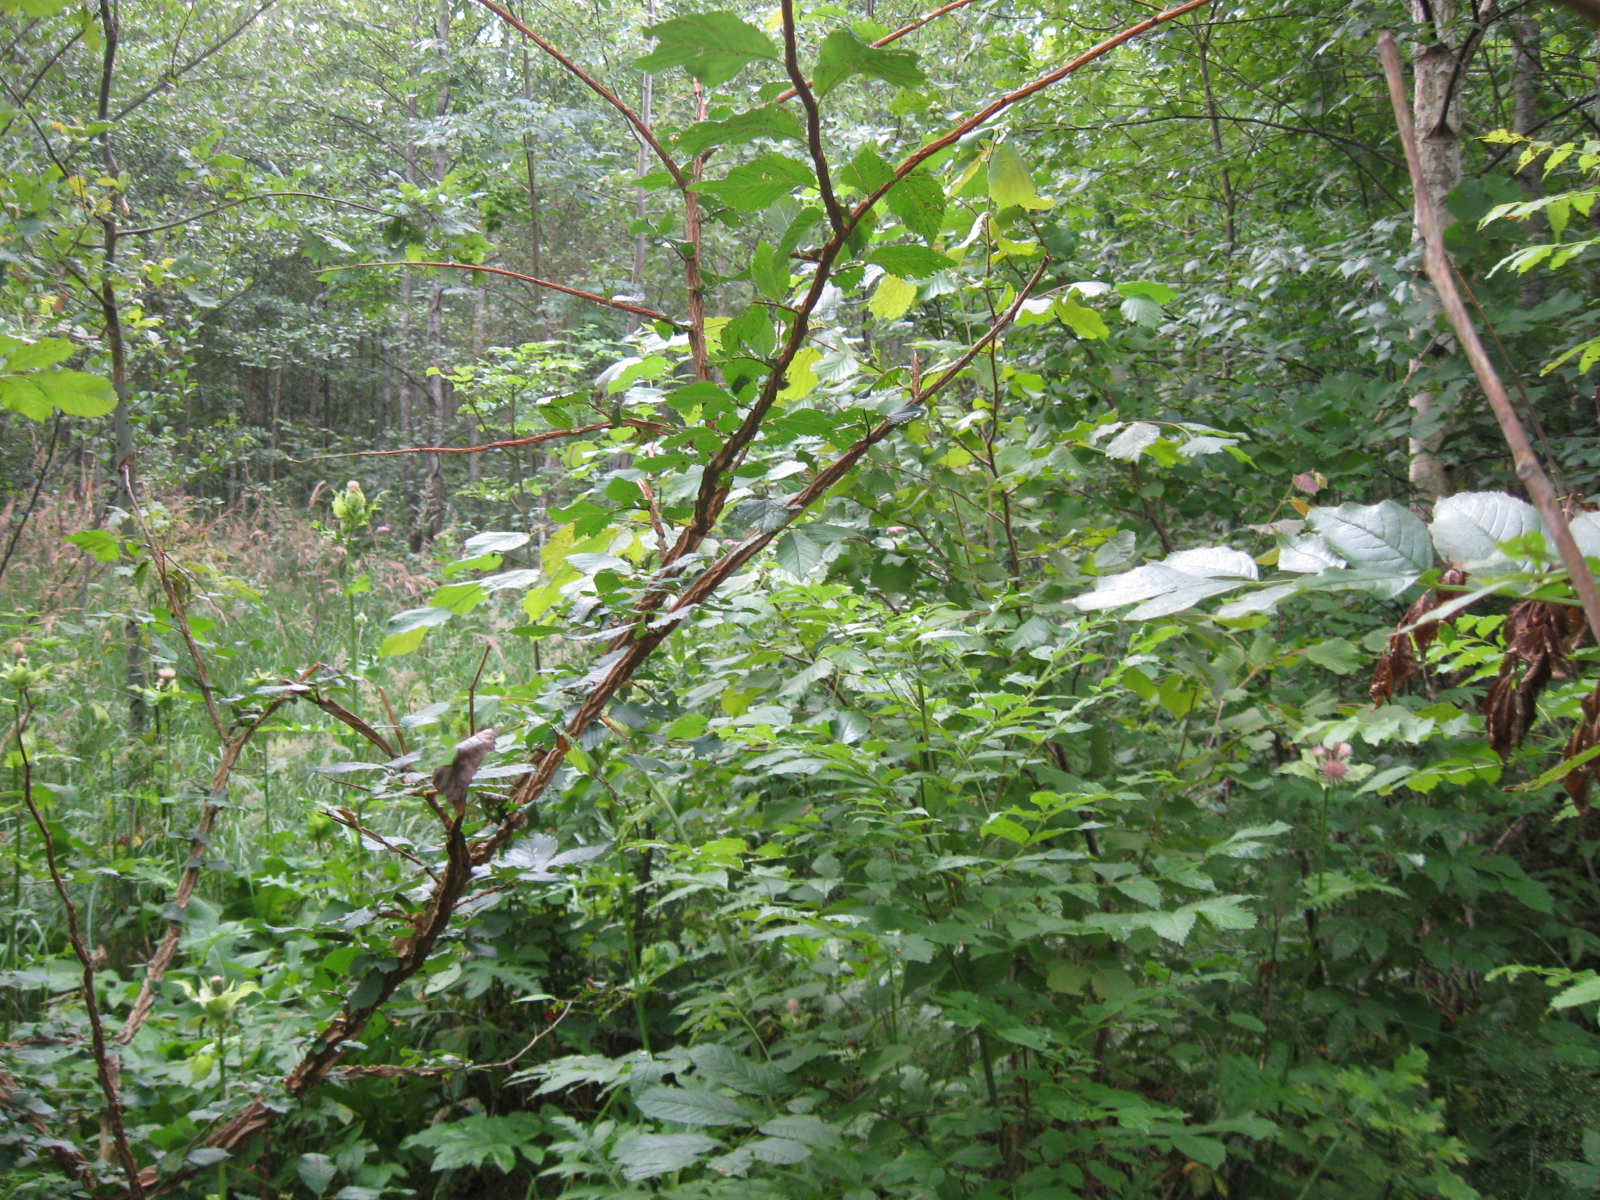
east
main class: Woodland
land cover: Broadleaved woodland
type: mire and swamp forests
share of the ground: > 75 %
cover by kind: broadleaved forest trees 75 %, herbaceous plants 25 %
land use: Forestry
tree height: > 5 m
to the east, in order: Broadleaved woodland; Other mixed woodland; Ditches and canals; Spontaneously vegetated surfaces; Other mixed woodland
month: July
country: LT
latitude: 54.4528
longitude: 23.4534
